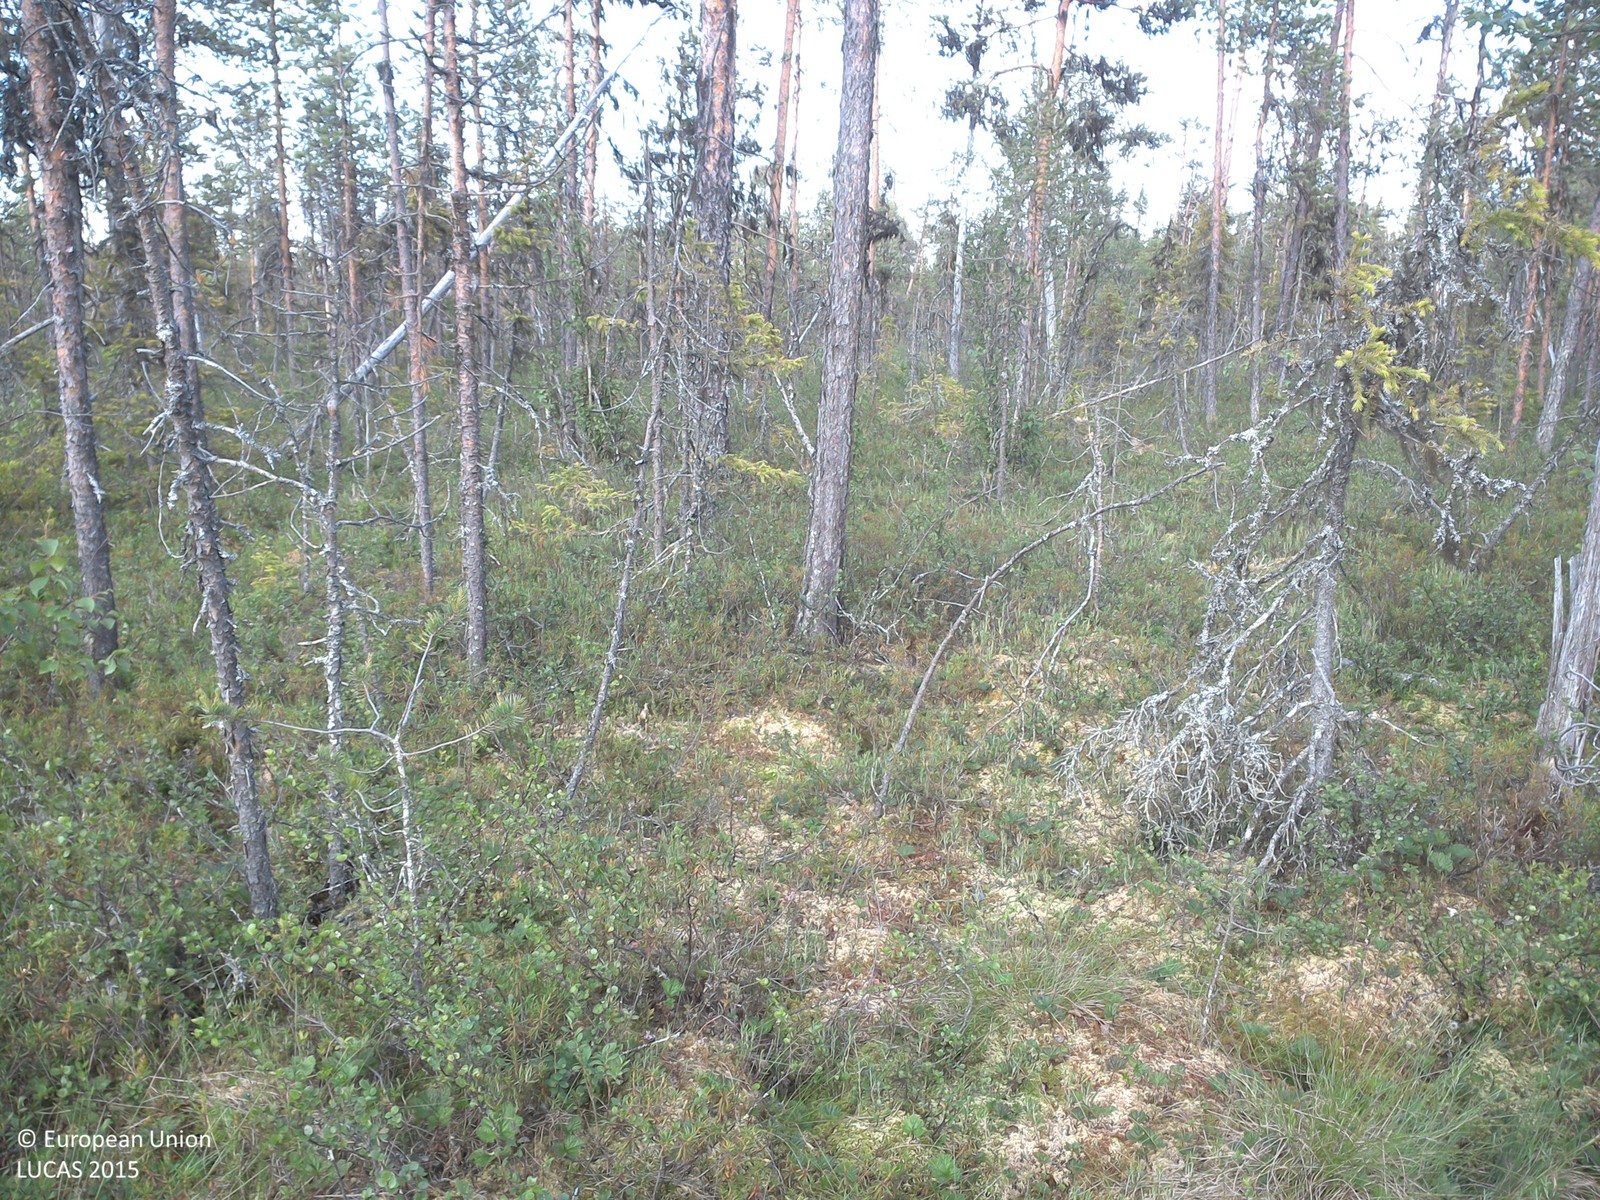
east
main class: Woodland
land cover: Pine dominated coniferous woodland
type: boreal forest
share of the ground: 10 - 25 %
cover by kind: shrubs 40 %, lichens and mosses 25 %, herbaceous plants 20 %, coniferous forest trees 15 %
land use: Semi-natural and natural areas not in use
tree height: > 5 m
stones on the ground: < 10 %
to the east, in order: Pine dominated coniferous woodland; Other coniferous woodland; Pine dominated coniferous woodland
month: July
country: SE
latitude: 67.0761
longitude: 22.7815
